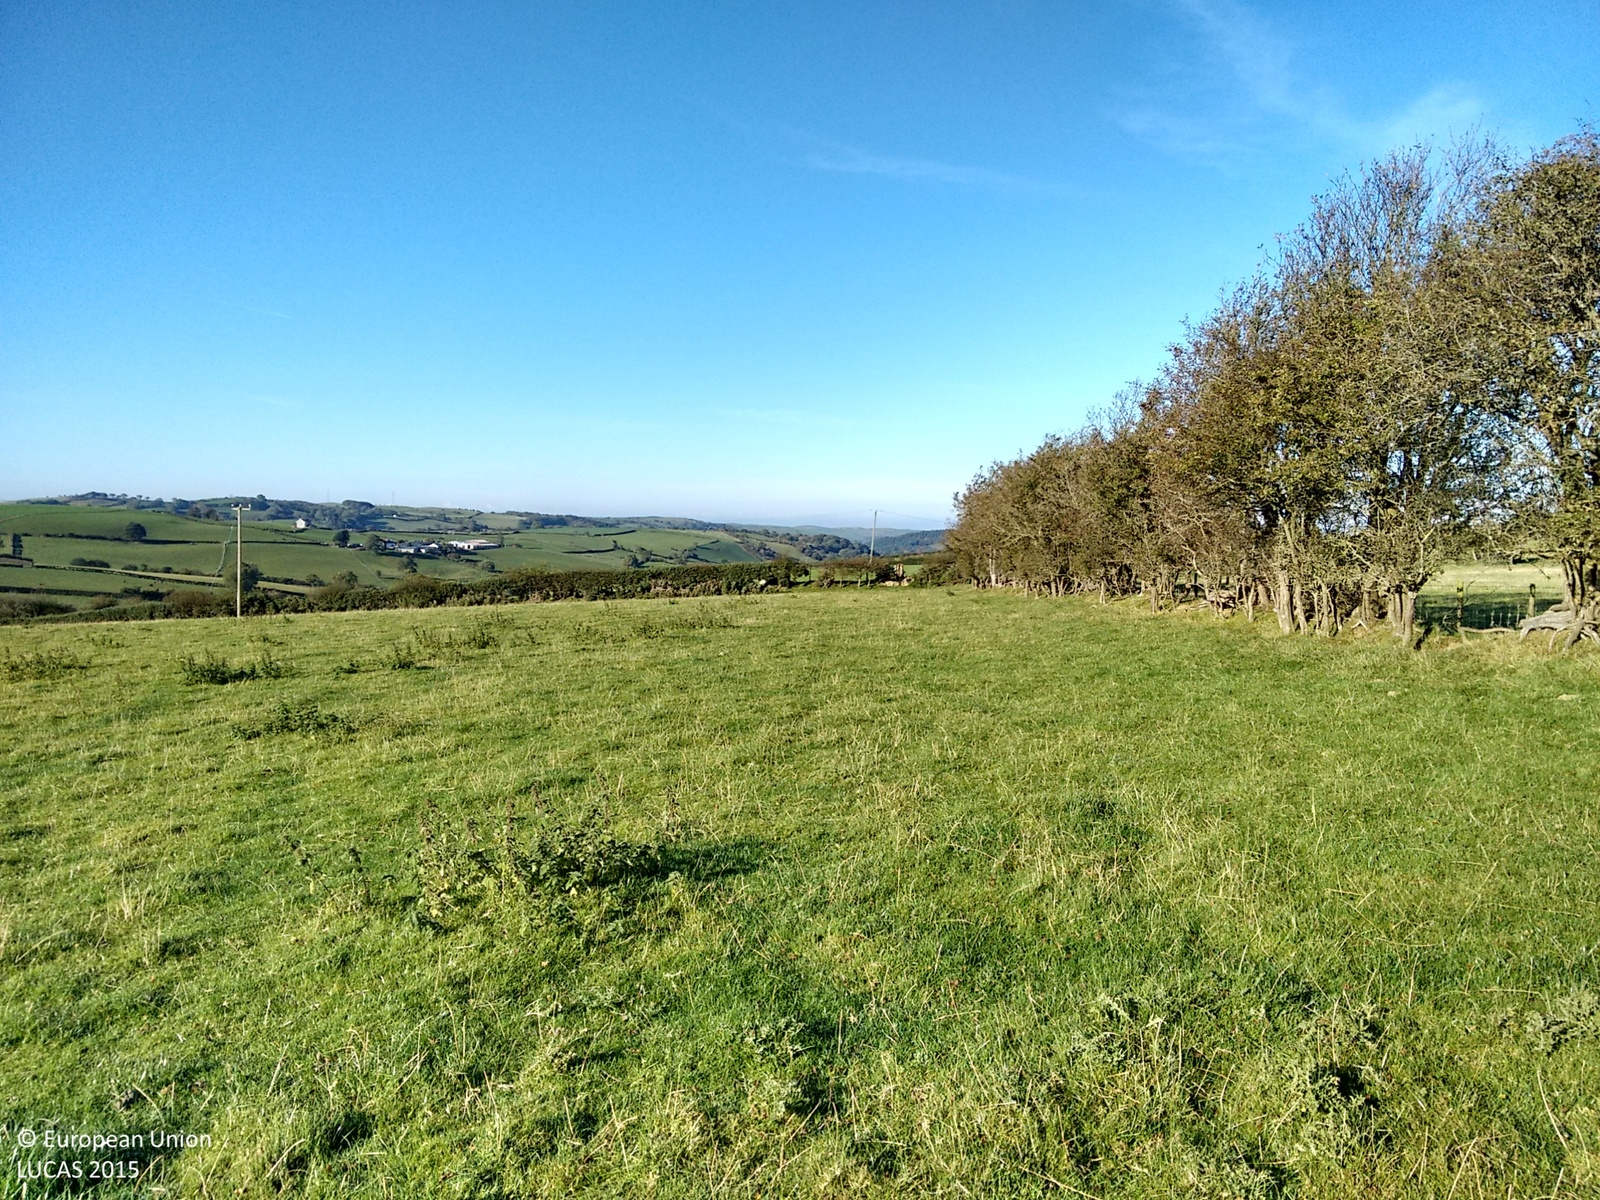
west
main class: Grassland
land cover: Grassland without tree/shrub cover
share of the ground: > 75 %
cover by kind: herbaceous plants 100 %
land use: Agriculture (excluding fallow land and kitchen gardens)
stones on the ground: < 10 %
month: October
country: GB
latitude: 52.3848
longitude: -3.9784
